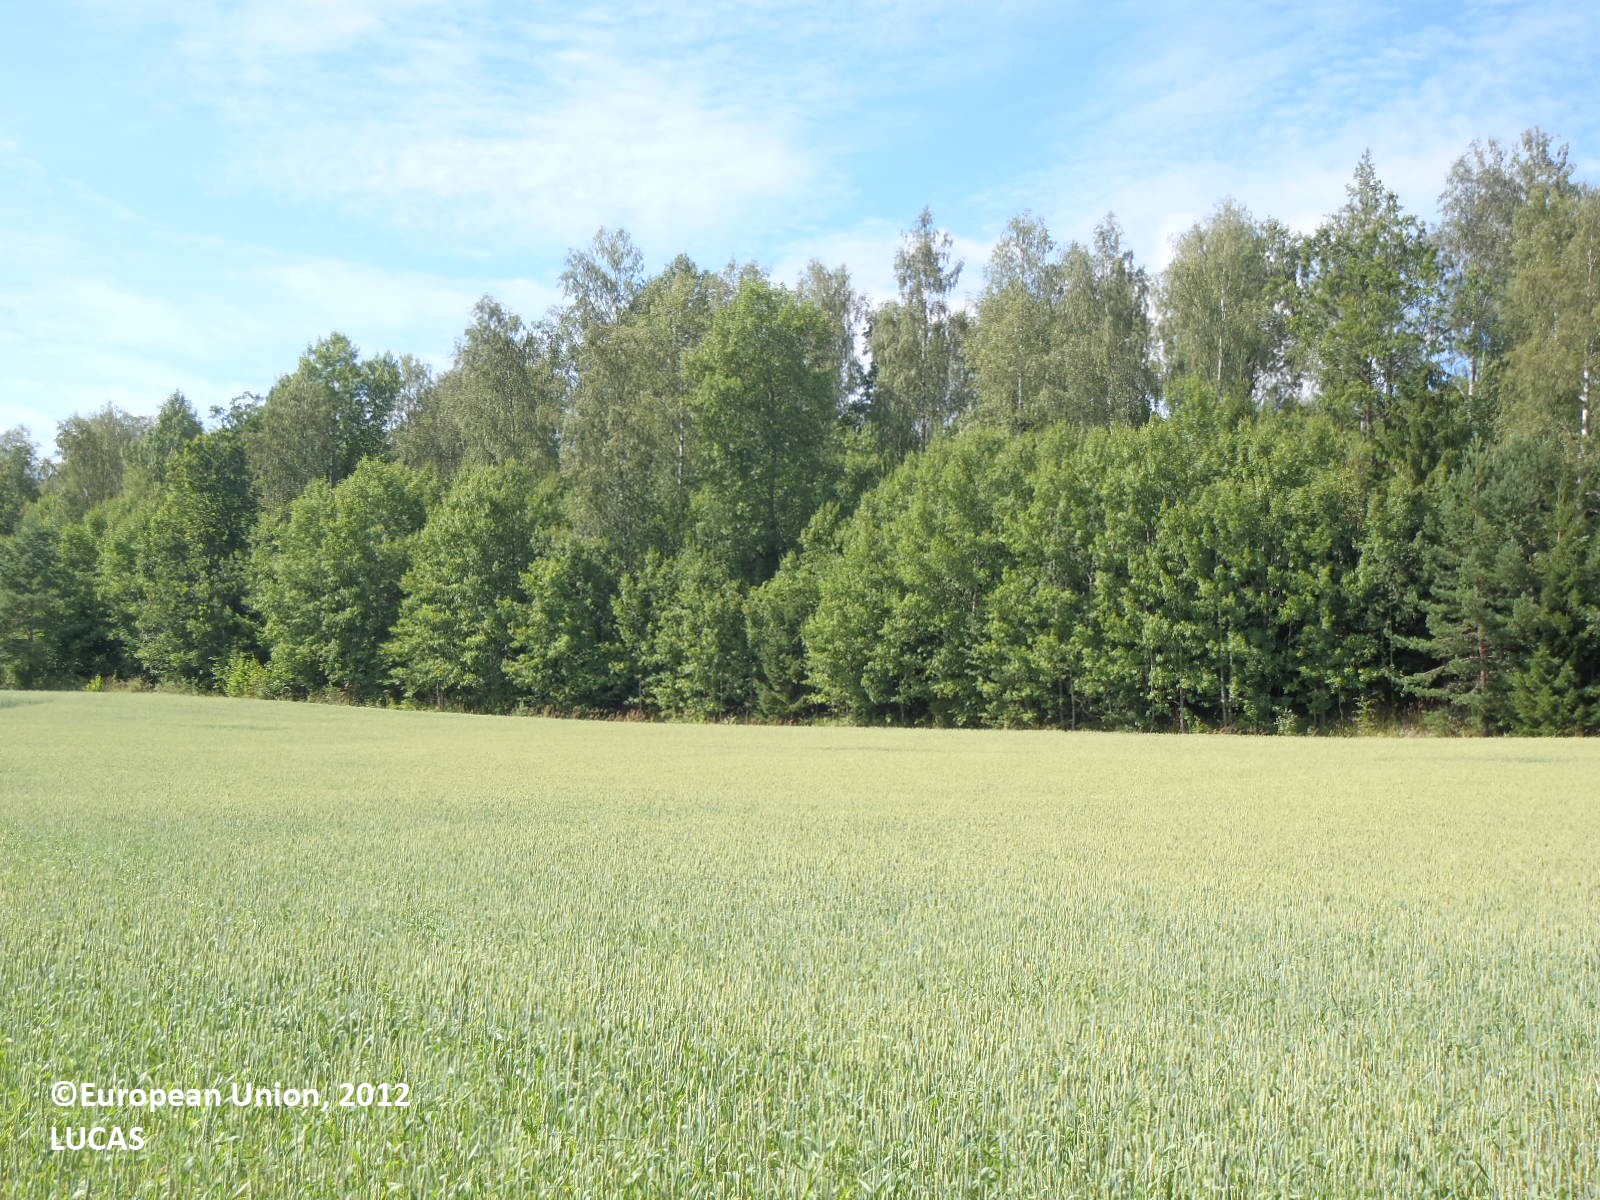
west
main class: Cropland
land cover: Common wheat
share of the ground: > 75 %
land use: Agriculture (excluding fallow land and kitchen gardens)
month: August
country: FI
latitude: 60.3423
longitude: 22.4079
